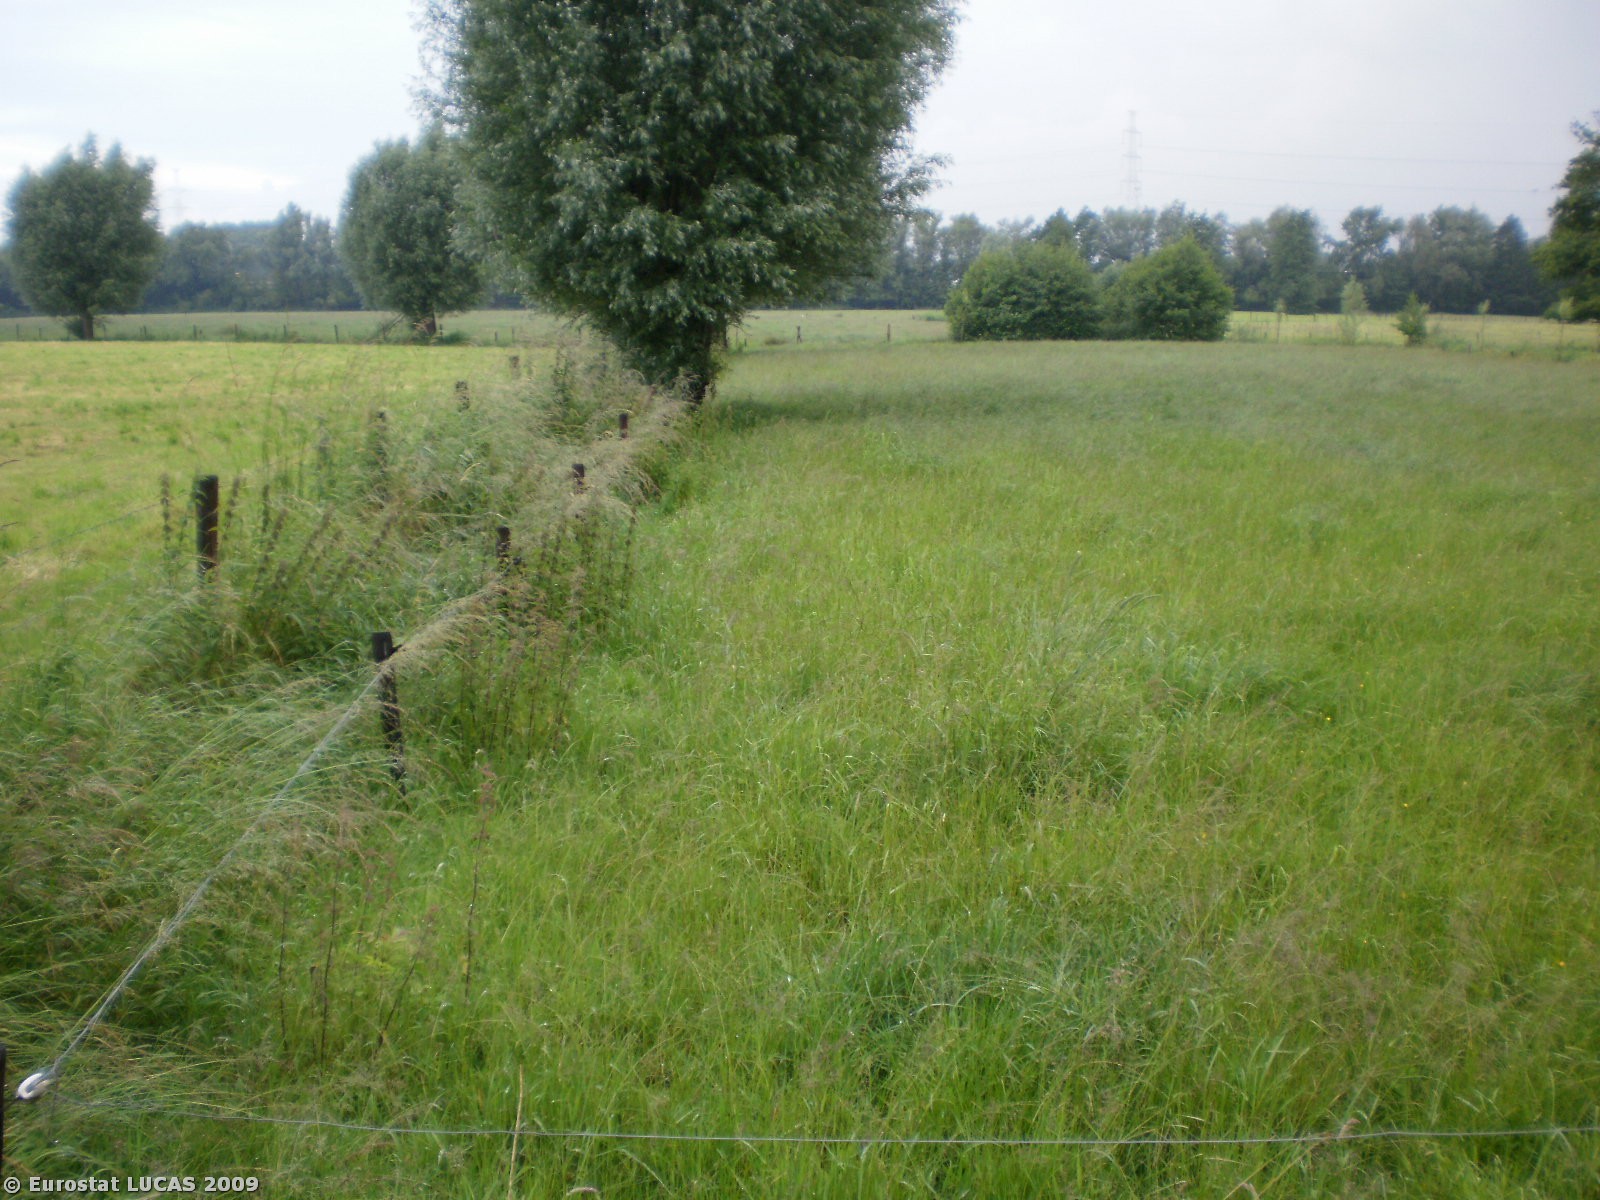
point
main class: Grassland
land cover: Grassland without tree/shrub cover
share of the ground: > 75 %
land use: Agriculture (excluding fallow land and kitchen gardens)
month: June
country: BE
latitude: 51.1337
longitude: 4.1496
